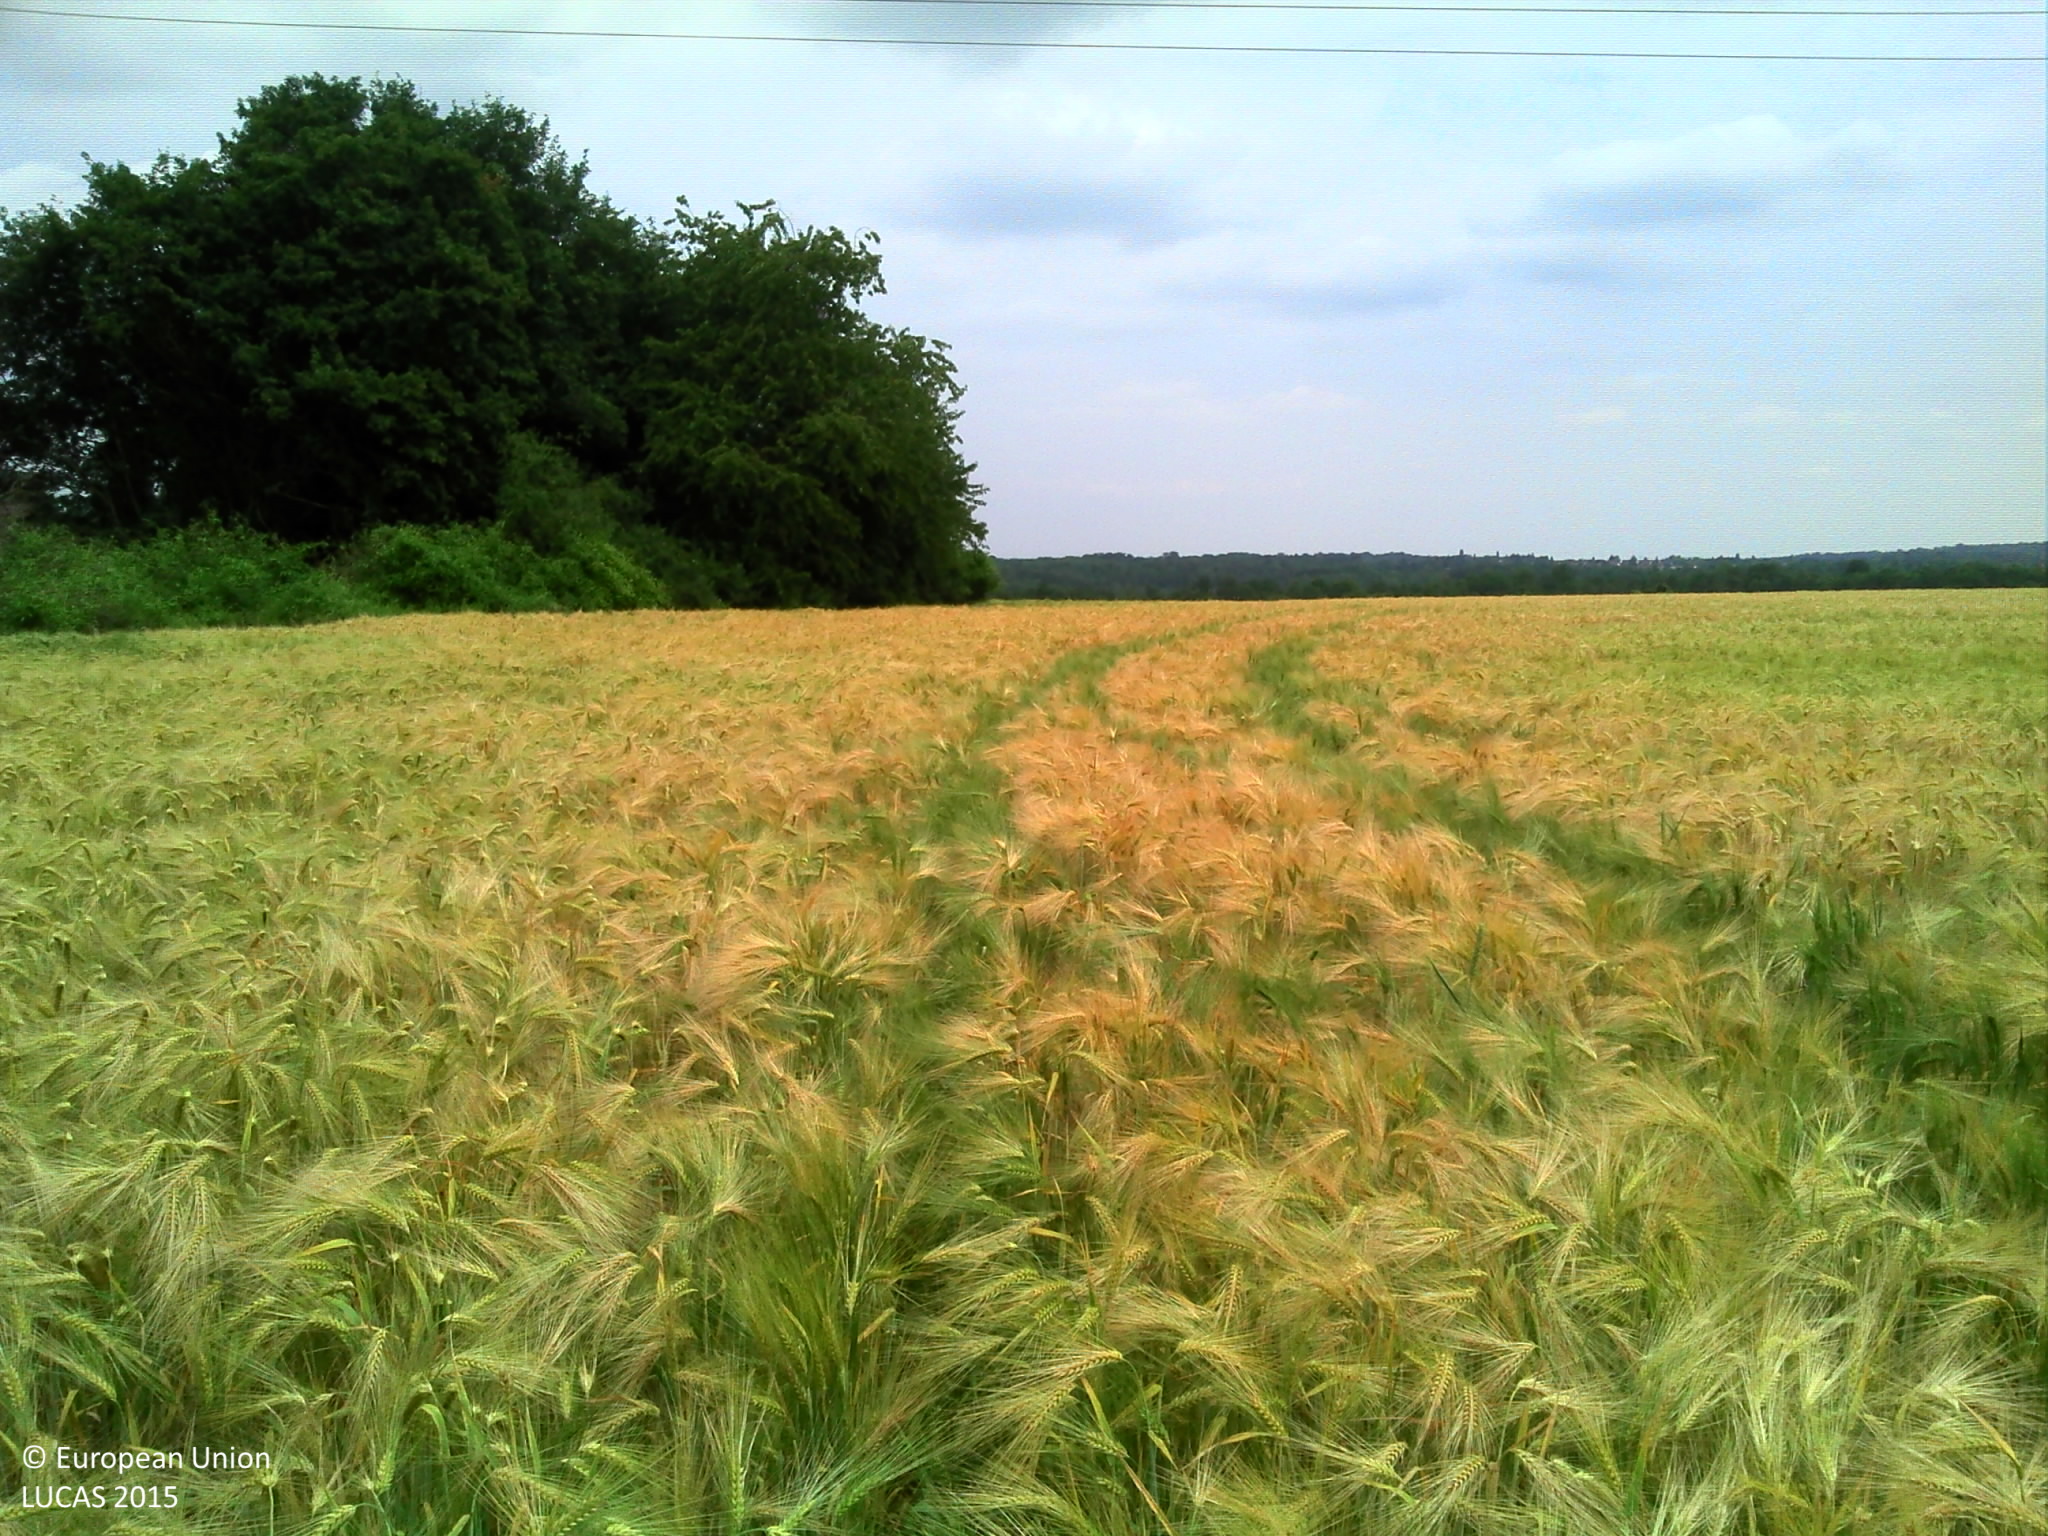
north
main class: Cropland
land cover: Barley
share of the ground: > 75 %
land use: Agriculture (excluding fallow land and kitchen gardens)
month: June
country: FR
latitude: 48.7470
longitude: 6.0422
